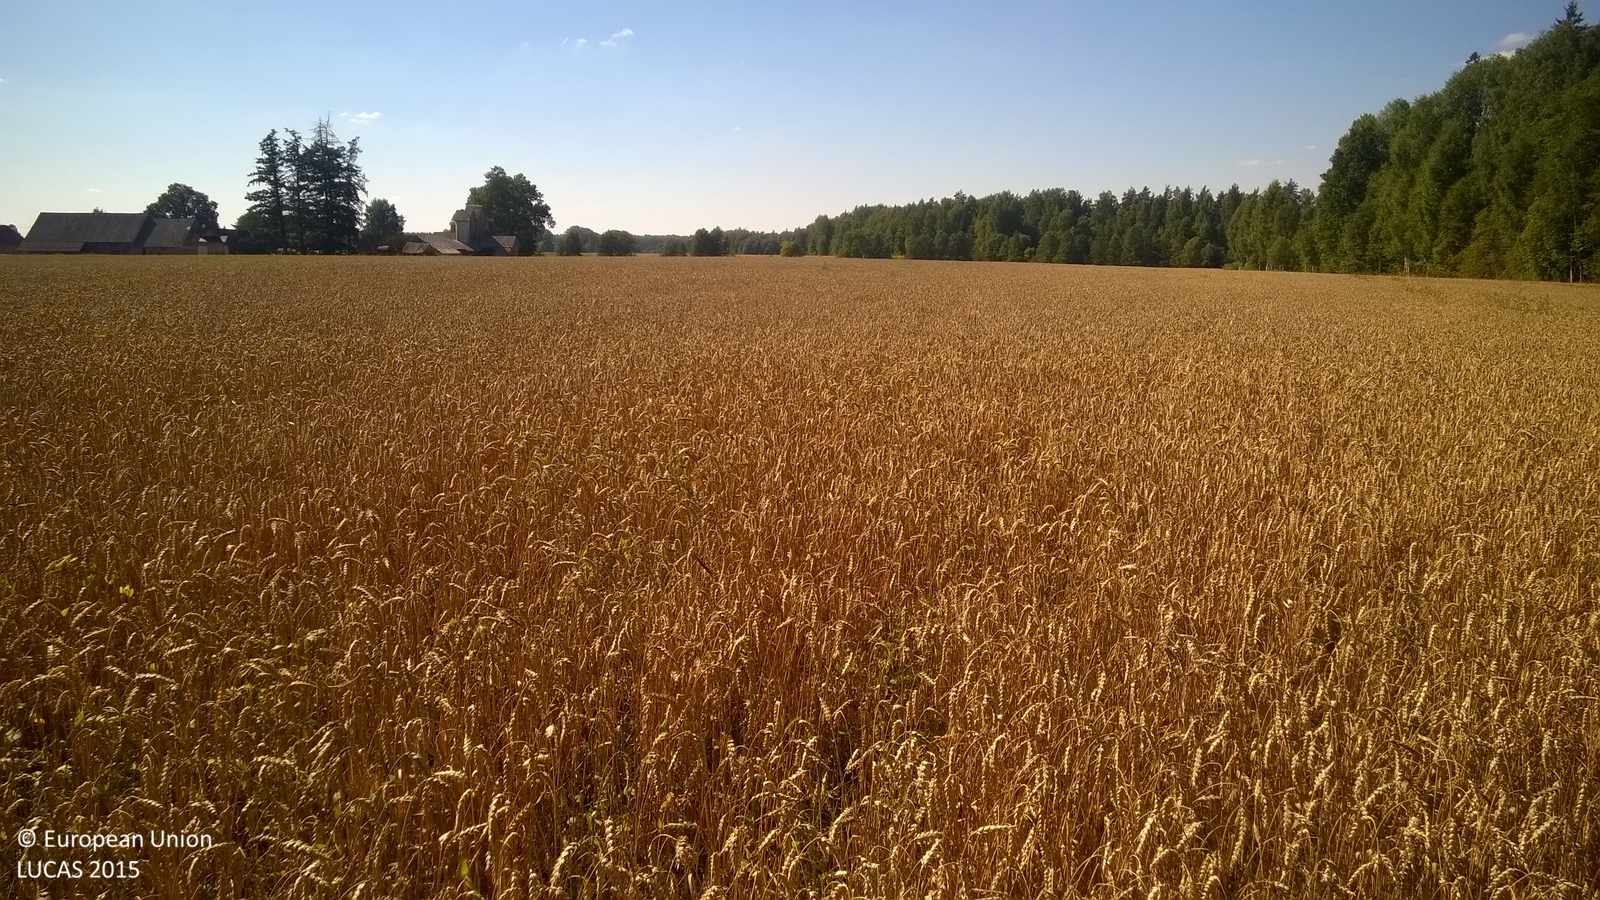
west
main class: Cropland
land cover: Common wheat
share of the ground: > 75 %
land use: Agriculture (excluding fallow land and kitchen gardens)
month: August
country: LV
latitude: 57.5476
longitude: 25.9844
